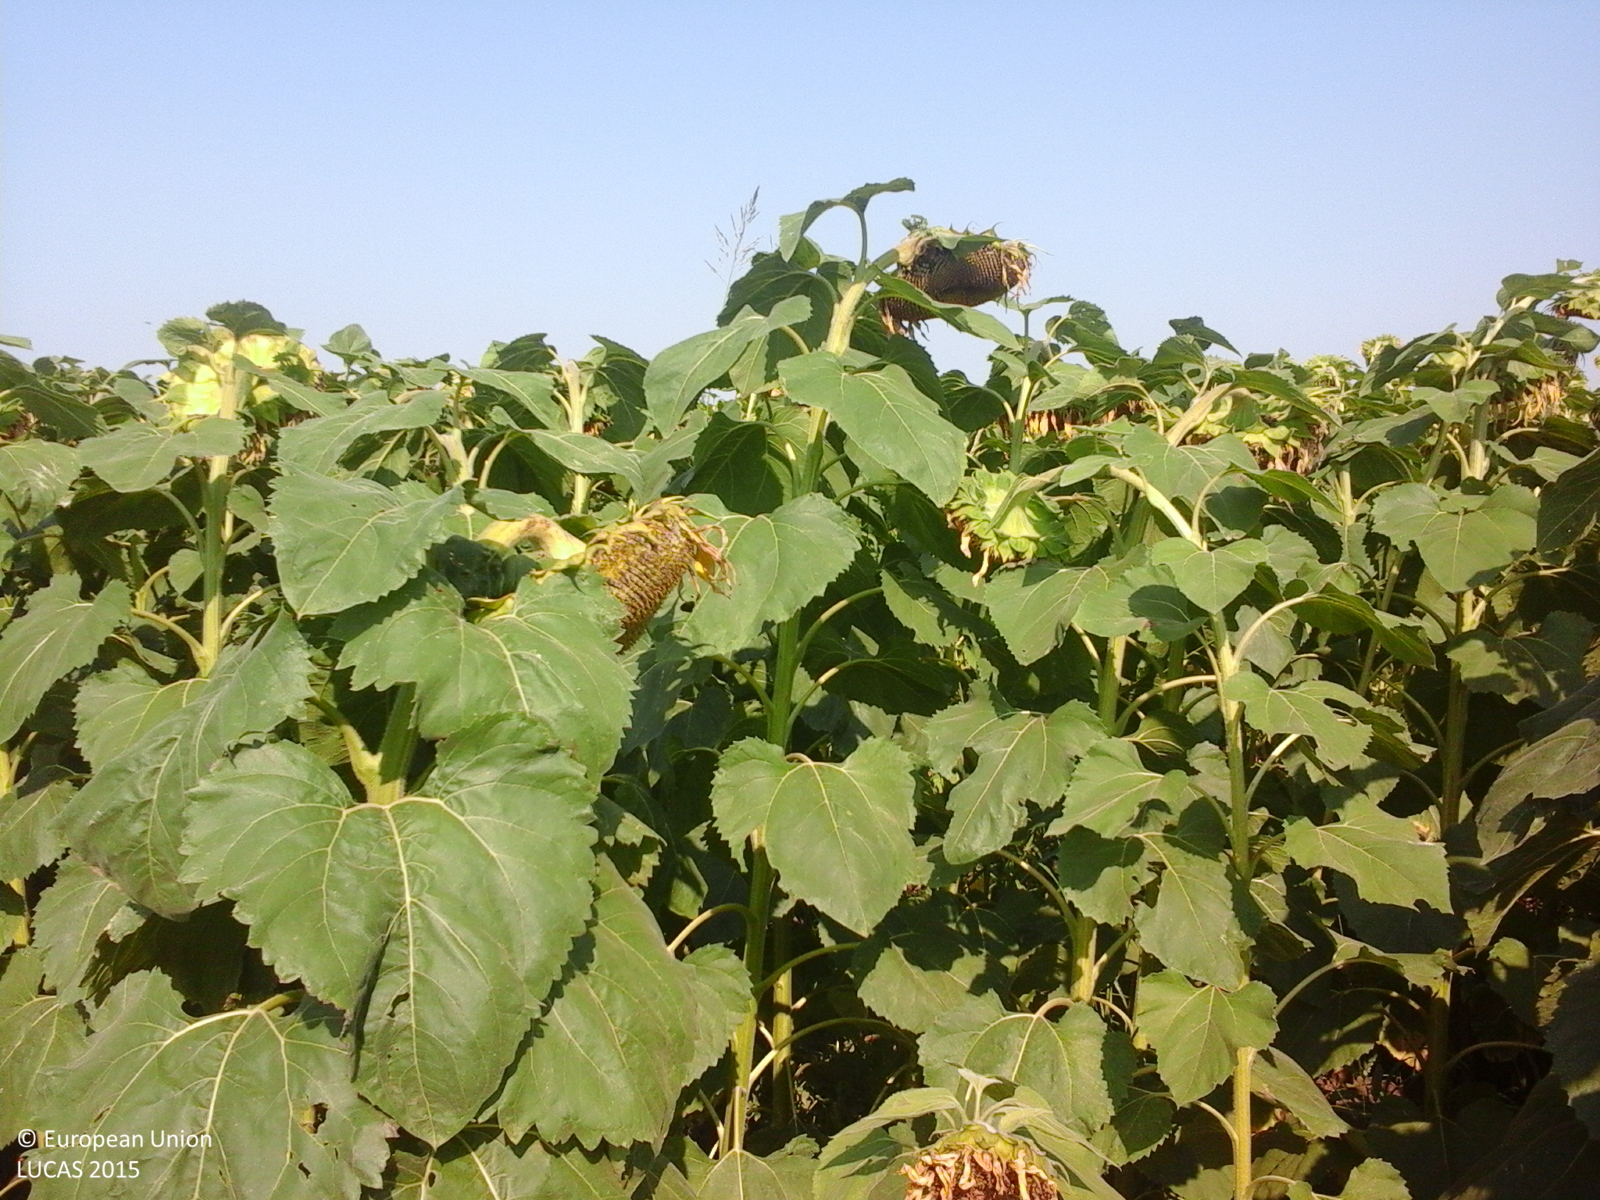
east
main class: Cropland
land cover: Sunflower
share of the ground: > 75 %
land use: Agriculture (excluding fallow land and kitchen gardens)
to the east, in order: Sunflower
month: July
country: RO
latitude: 44.8810
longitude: 27.1387
